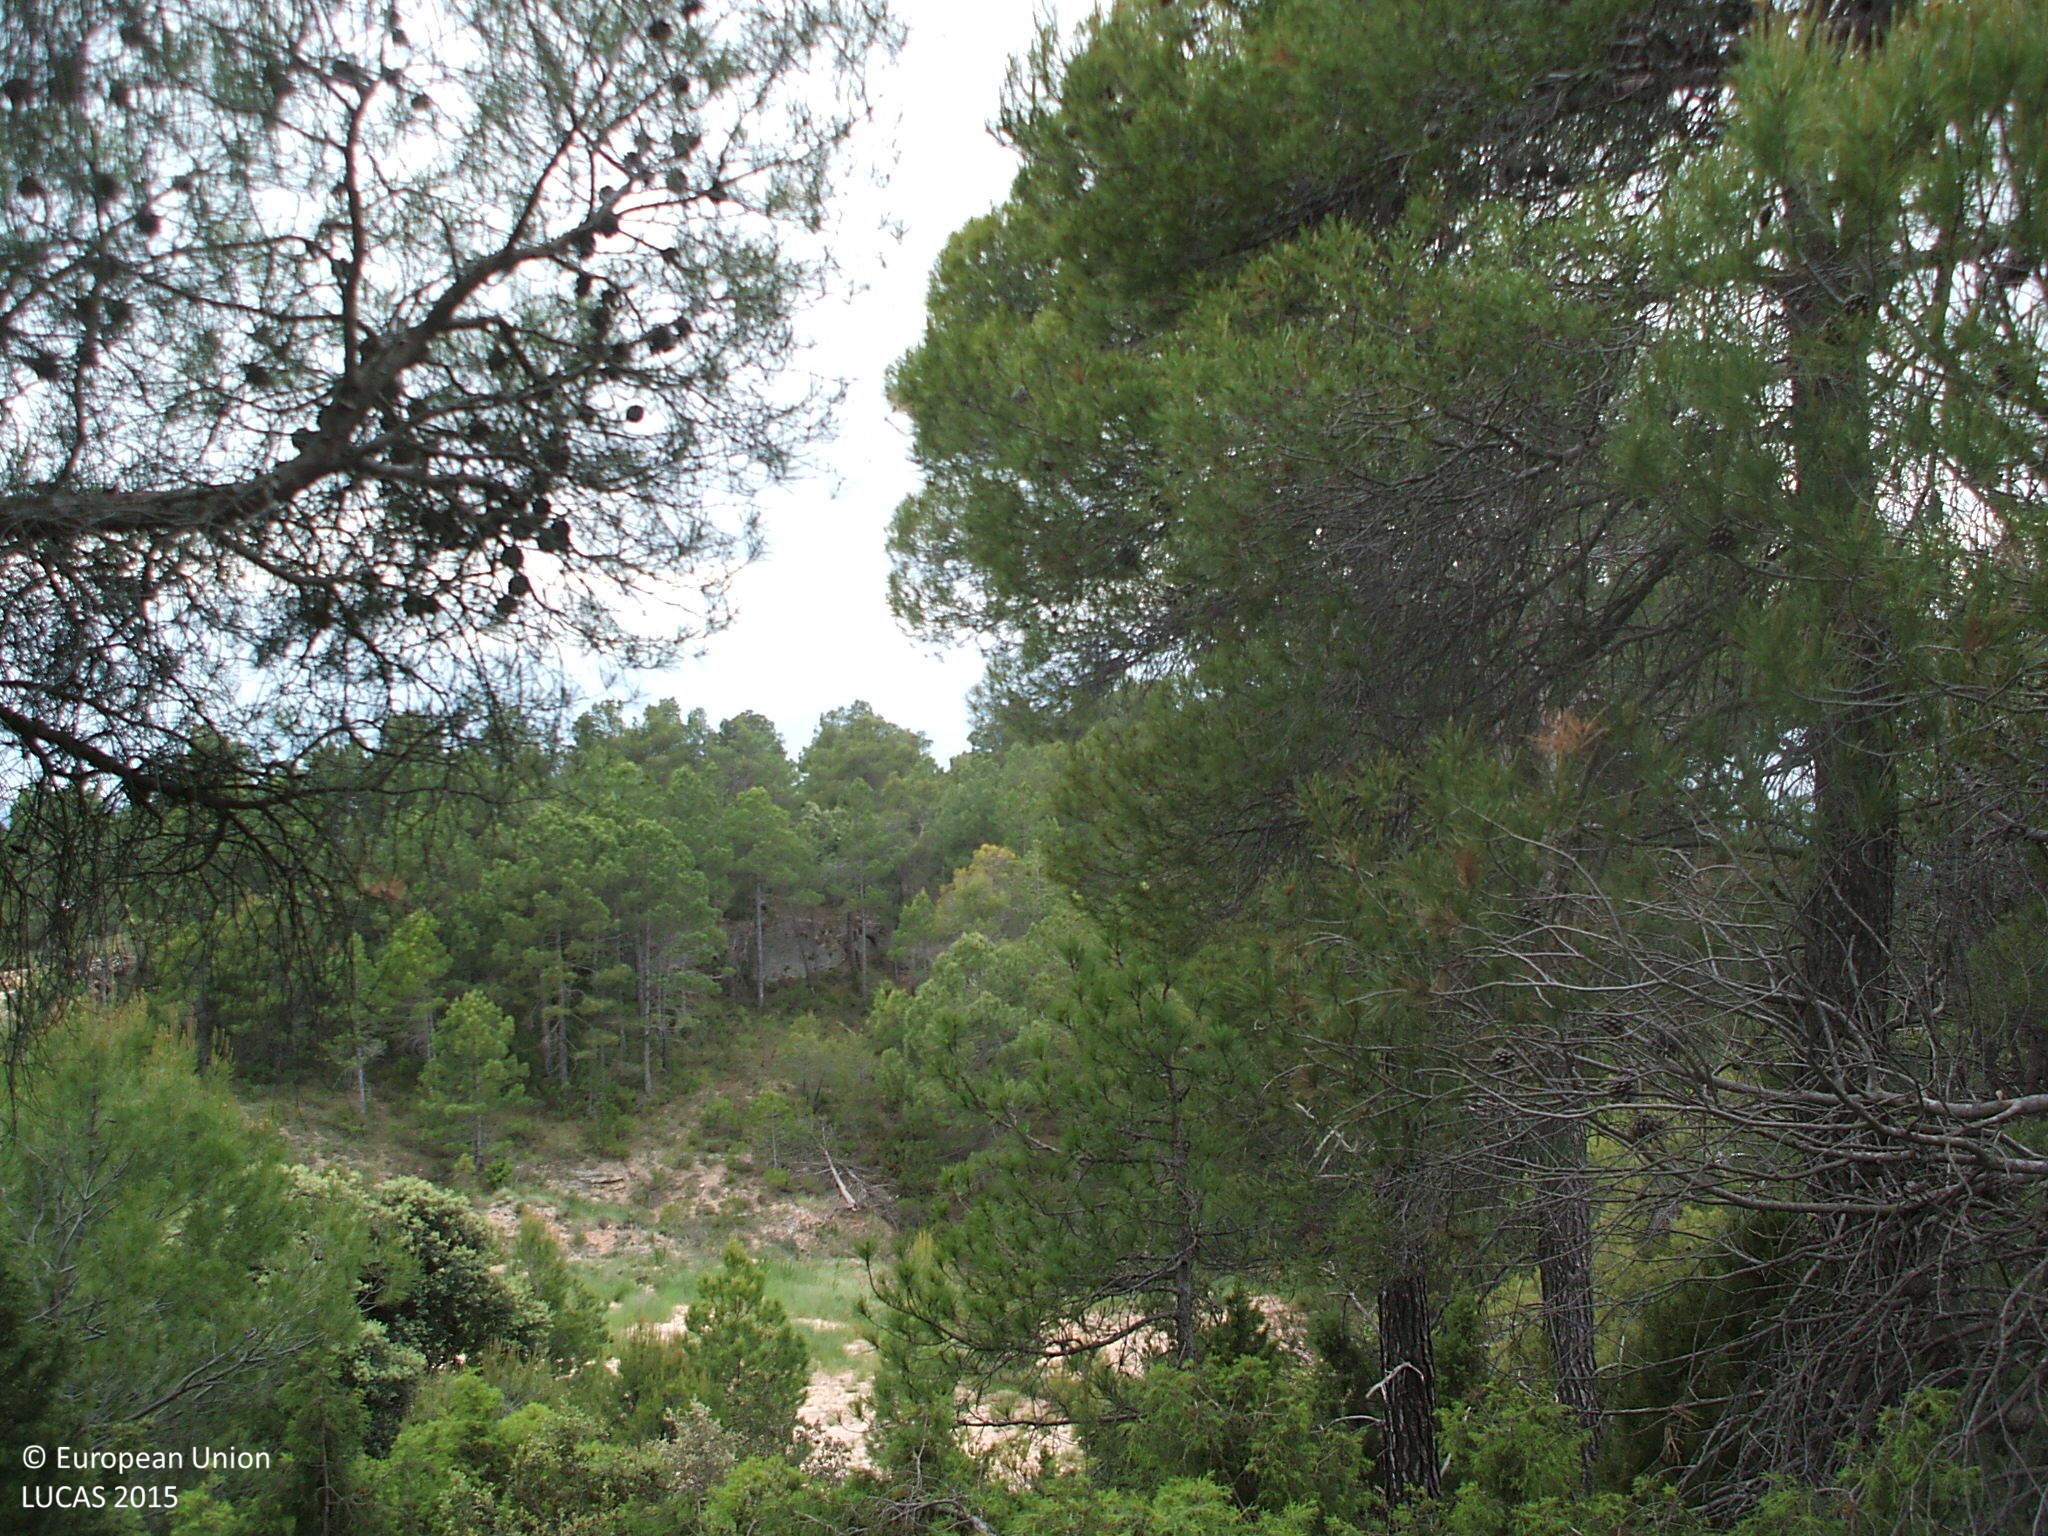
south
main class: Woodland
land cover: Pine dominated coniferous woodland
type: coniferous forest of the mediterranean region
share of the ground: > 75 %
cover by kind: coniferous forest trees 100 %
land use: Semi-natural and natural areas not in use
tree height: > 5 m
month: June
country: ES
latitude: 40.8268
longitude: -0.0284
